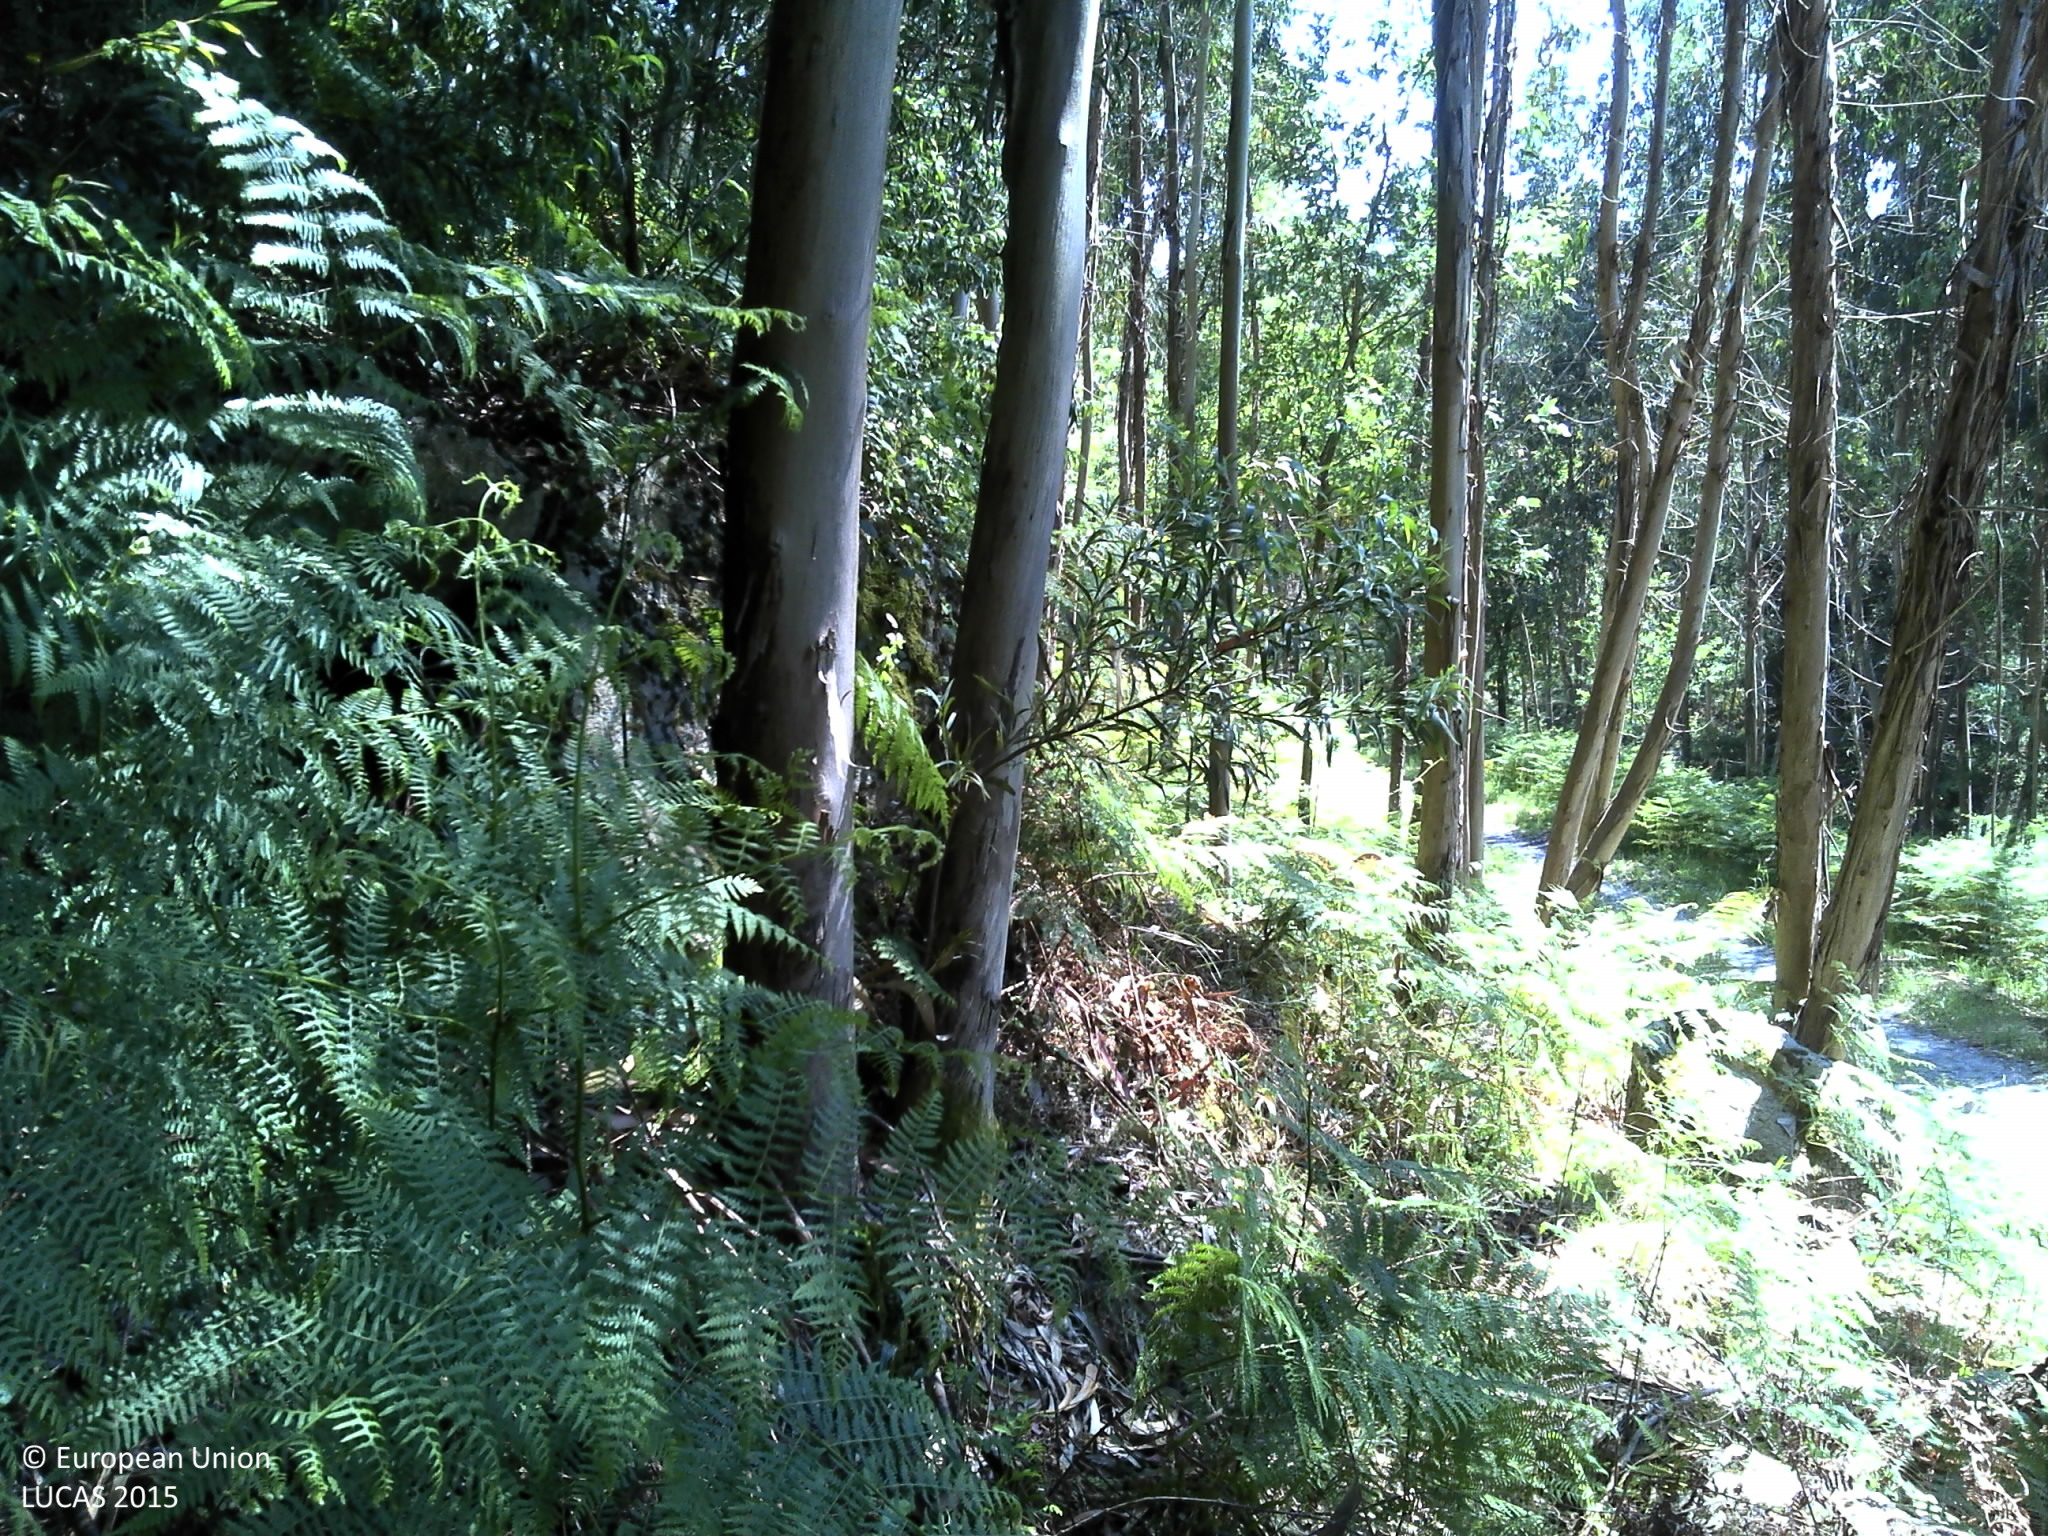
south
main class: Woodland
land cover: Broadleaved woodland
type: exotic forest
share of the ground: 50 - 75 %
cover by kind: broadleaved forest trees 50 %, shrubs 25 %, unconsolidated bare surface 25 %
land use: Forestry
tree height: > 5 m
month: May
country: PT
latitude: 41.7805
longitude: -8.6074
